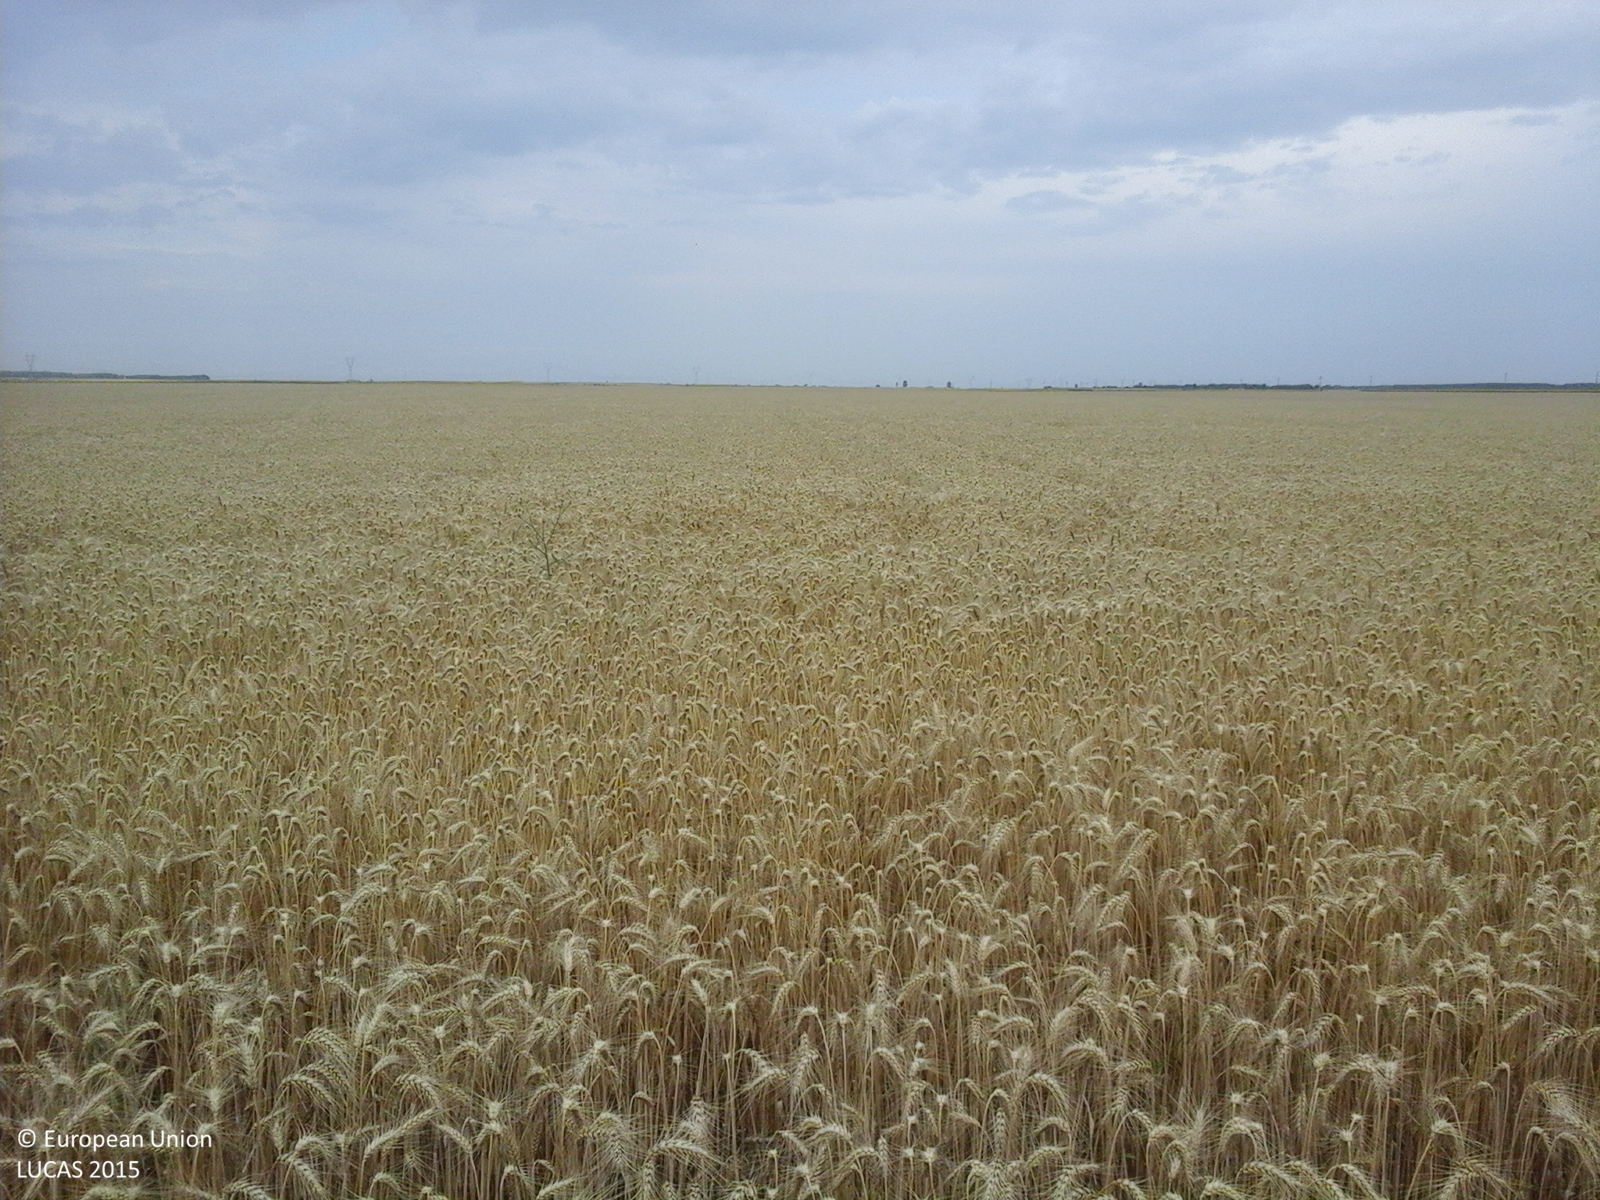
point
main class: Cropland
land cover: Common wheat
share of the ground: > 75 %
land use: Agriculture (excluding fallow land and kitchen gardens)
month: July
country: RO
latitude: 43.9678
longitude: 24.3599
